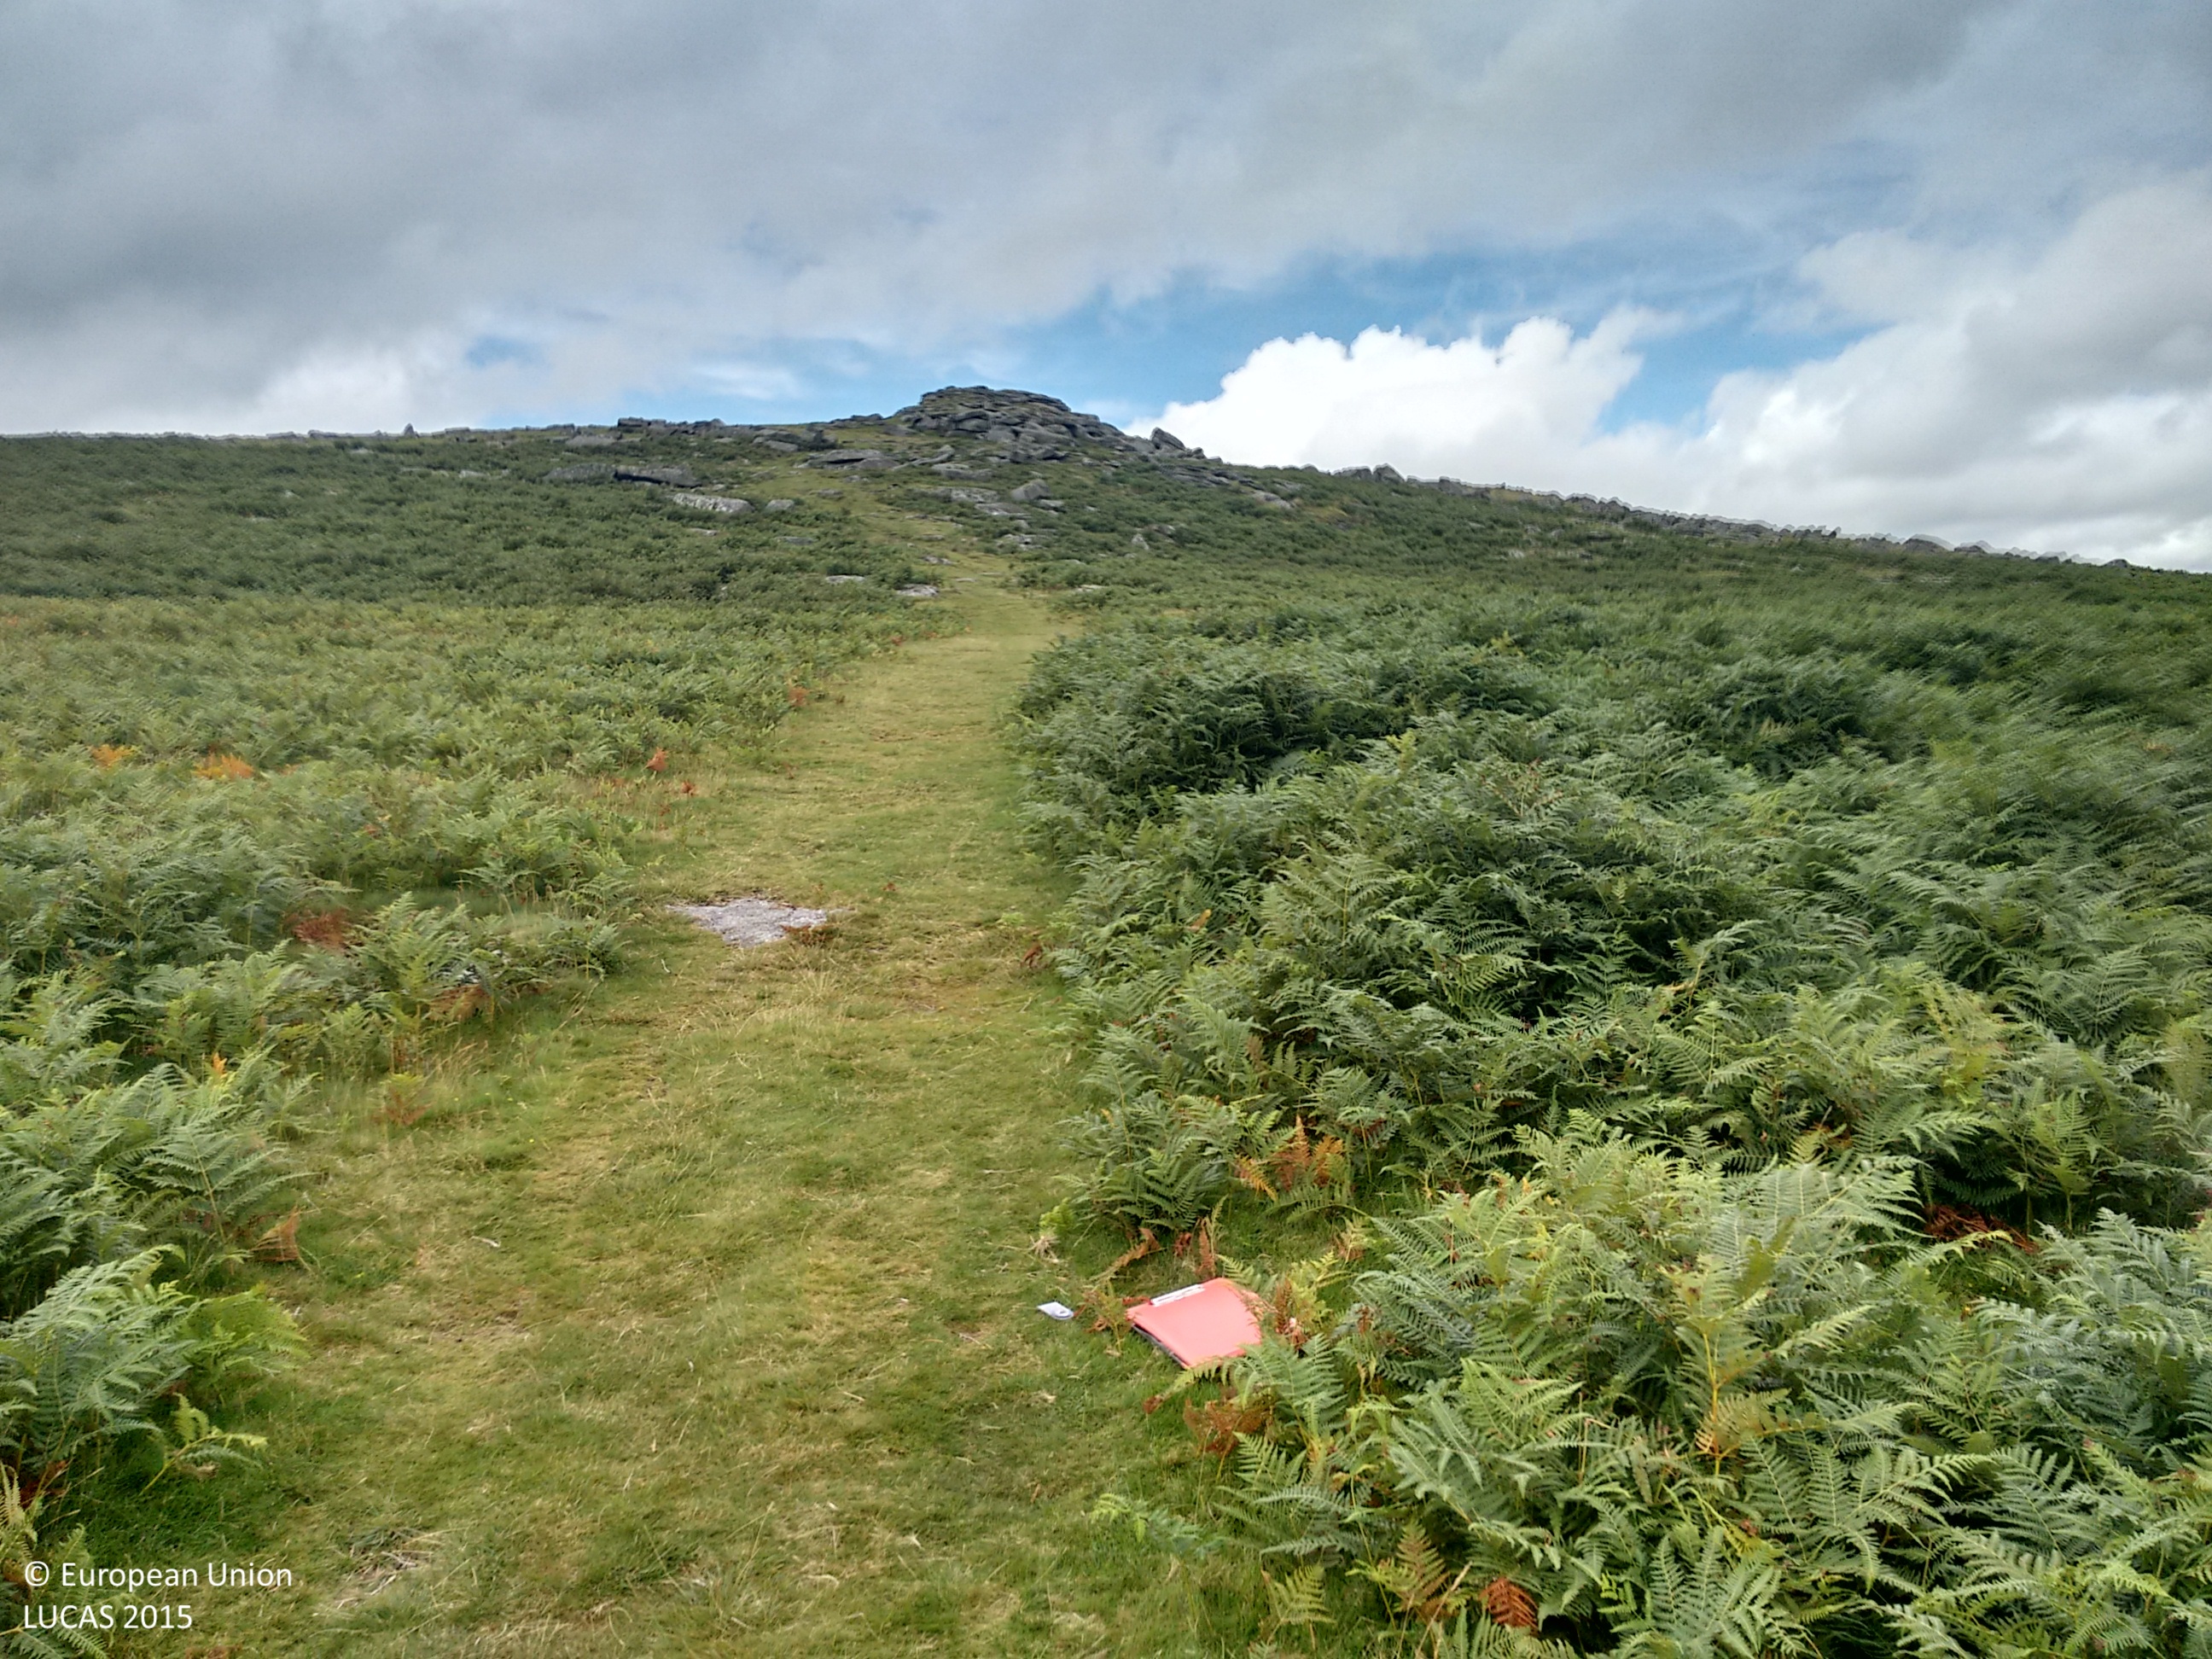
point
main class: Grassland
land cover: Grassland without tree/shrub cover
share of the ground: > 75 %
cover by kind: herbaceous plants 100 %
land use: Agriculture (excluding fallow land and kitchen gardens)
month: August
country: GB
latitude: 50.4829
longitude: -4.0037
